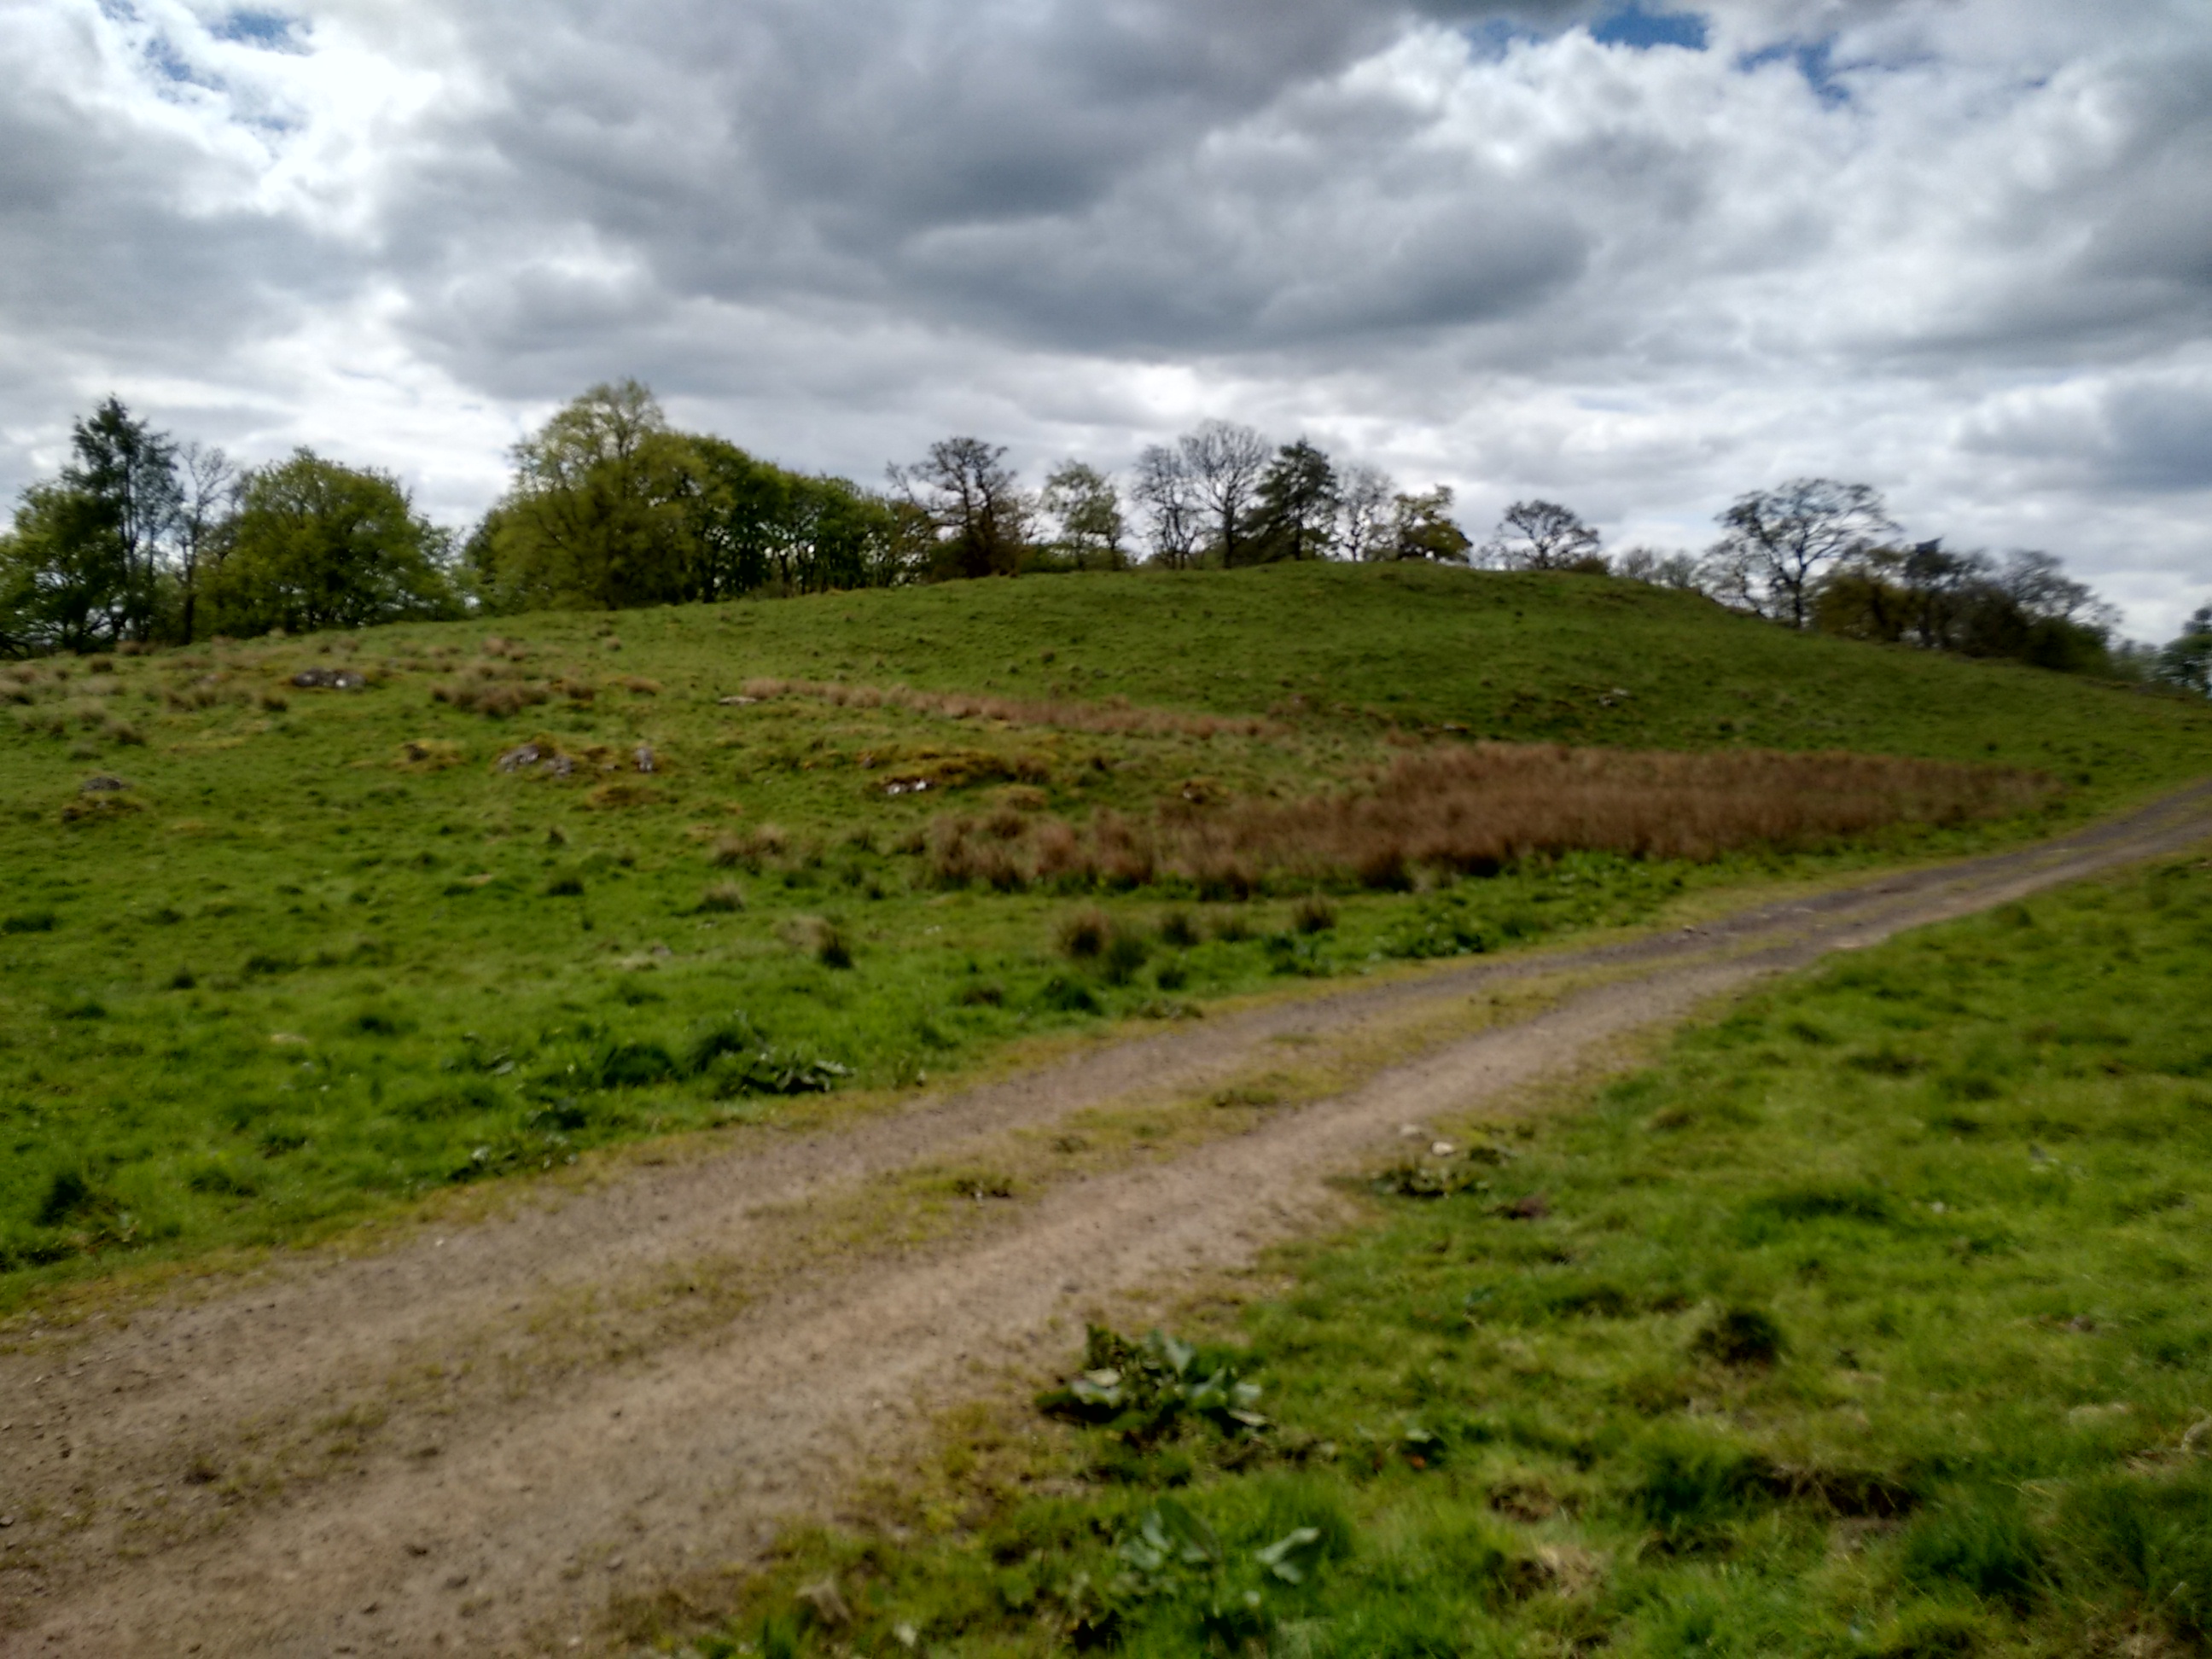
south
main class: Grassland
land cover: Grassland without tree/shrub cover
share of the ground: > 75 %
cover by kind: herbaceous plants 100 %
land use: Agriculture (excluding fallow land and kitchen gardens)
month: May
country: GB
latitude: 55.9476
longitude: -3.6432
